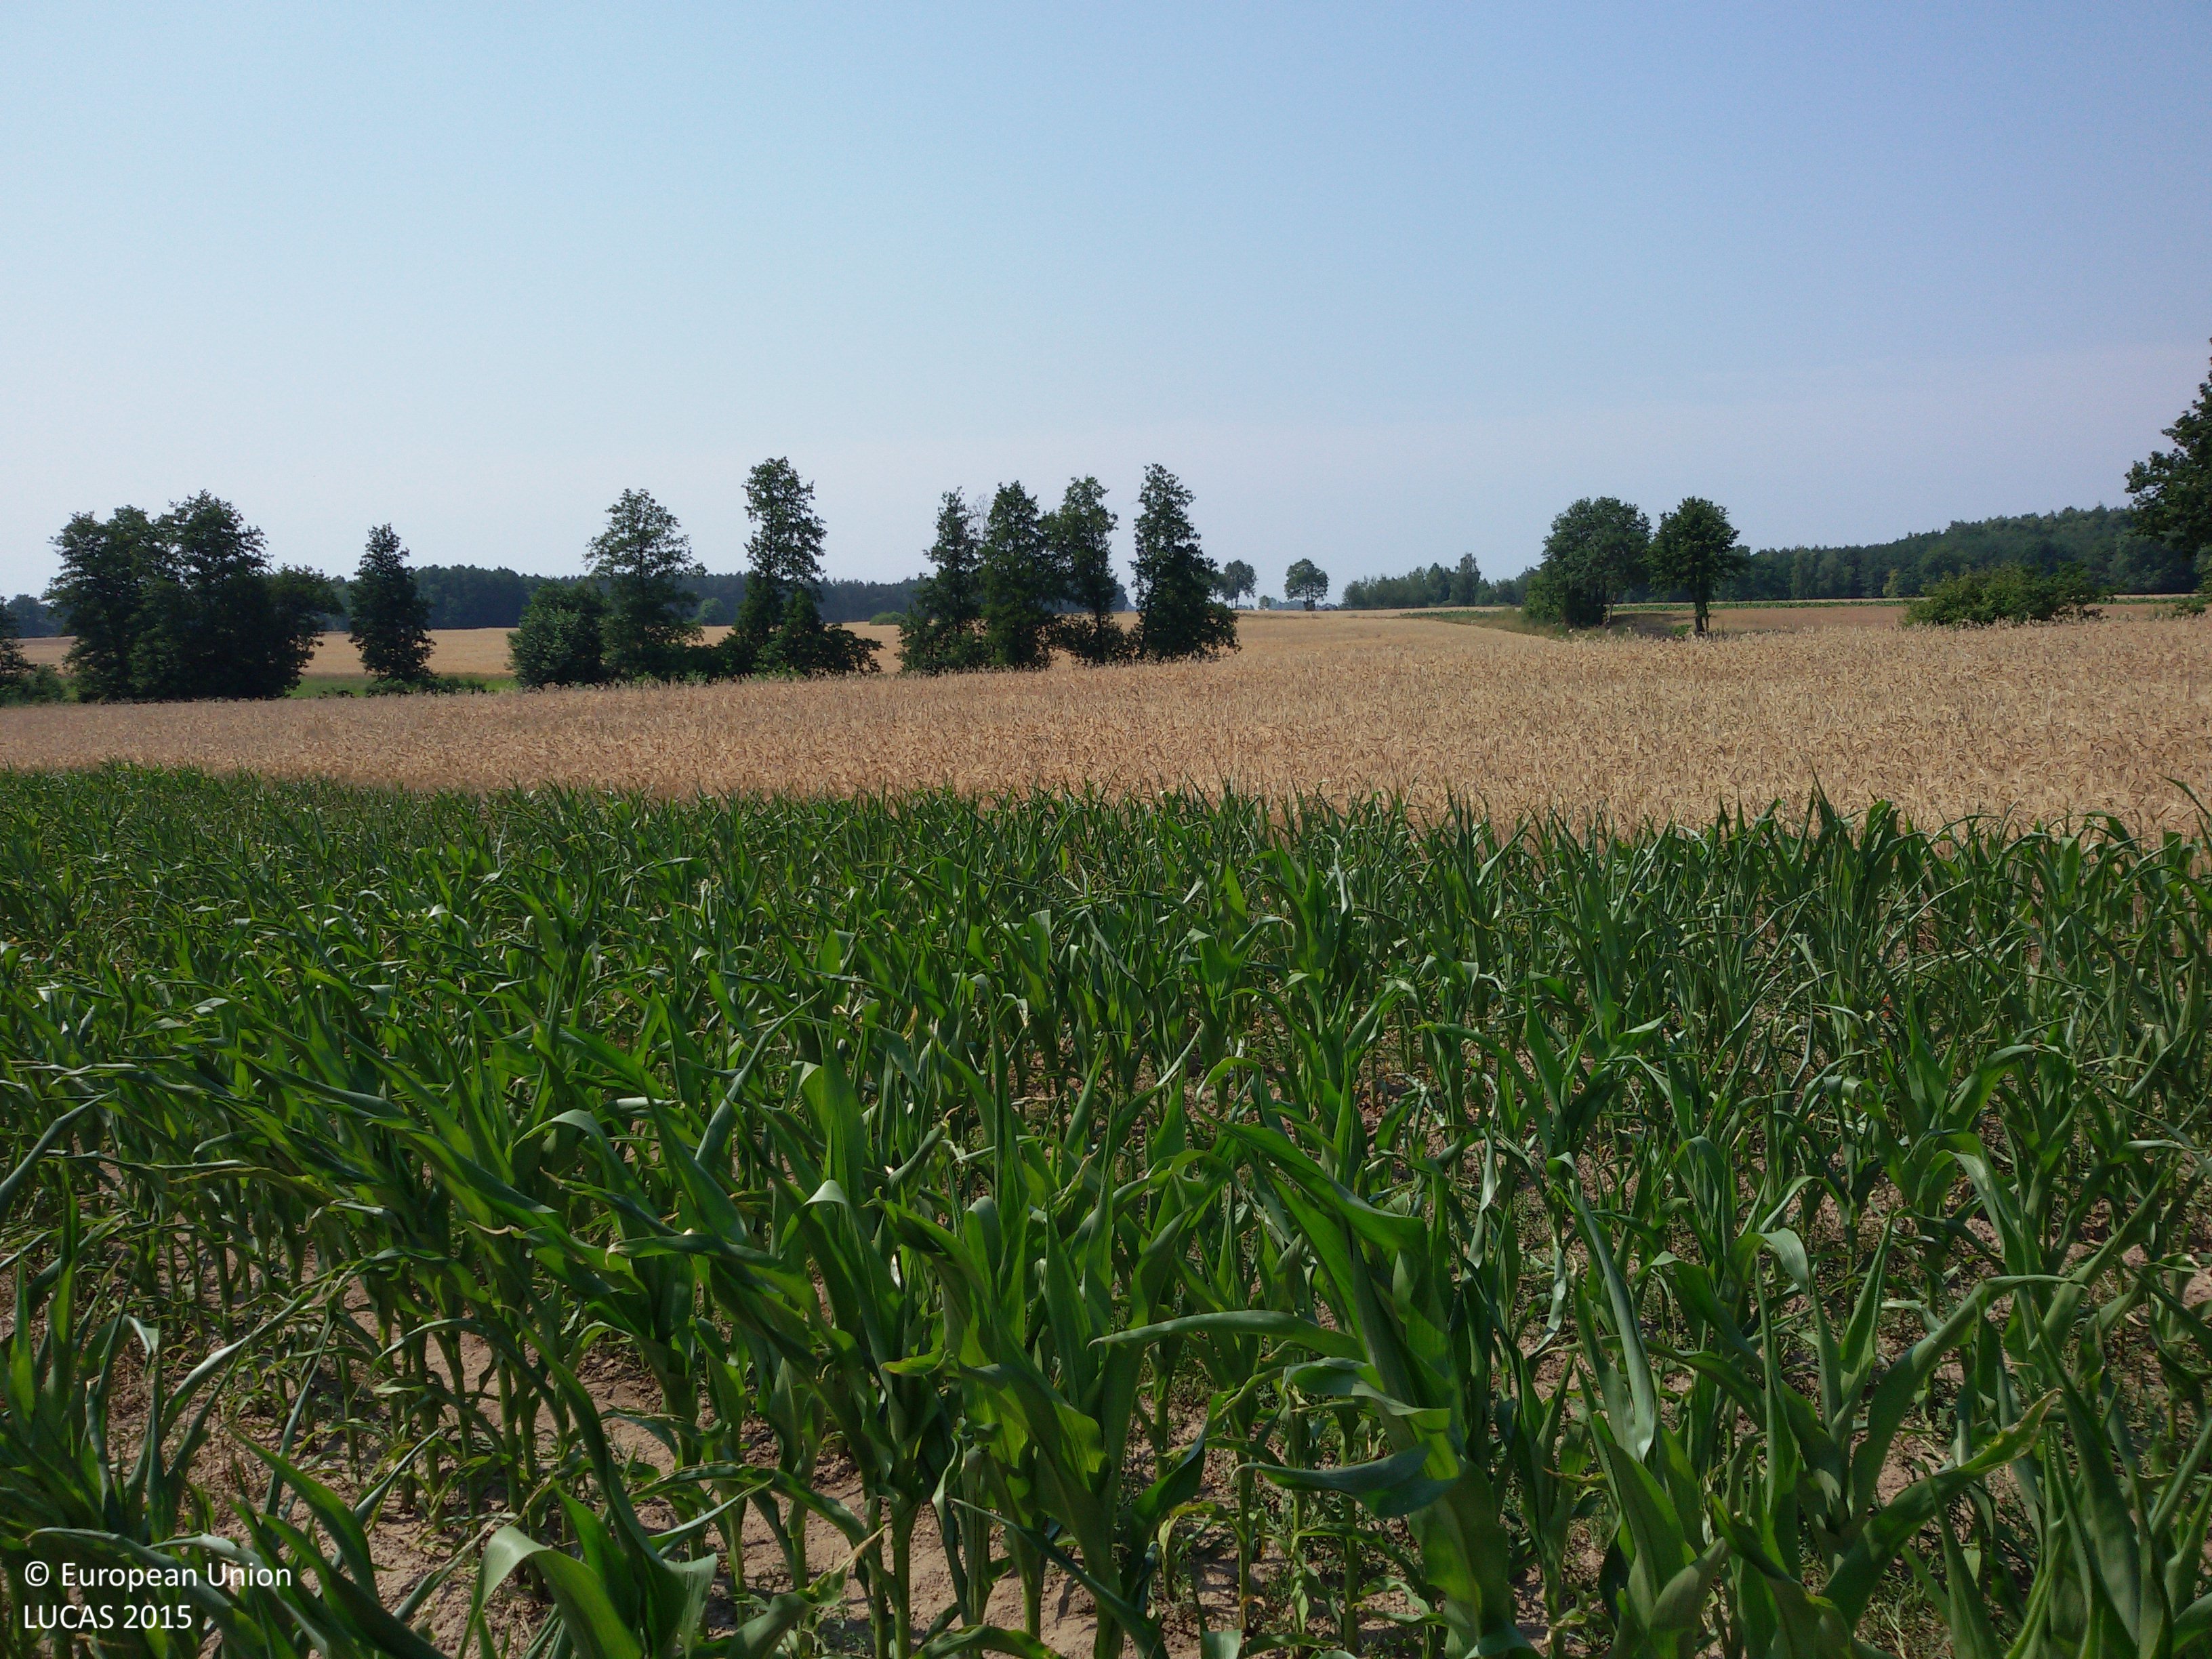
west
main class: Cropland
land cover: Maize
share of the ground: 50 - 75 %
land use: Agriculture (excluding fallow land and kitchen gardens)
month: July
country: PL
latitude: 53.2826
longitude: 17.7075
